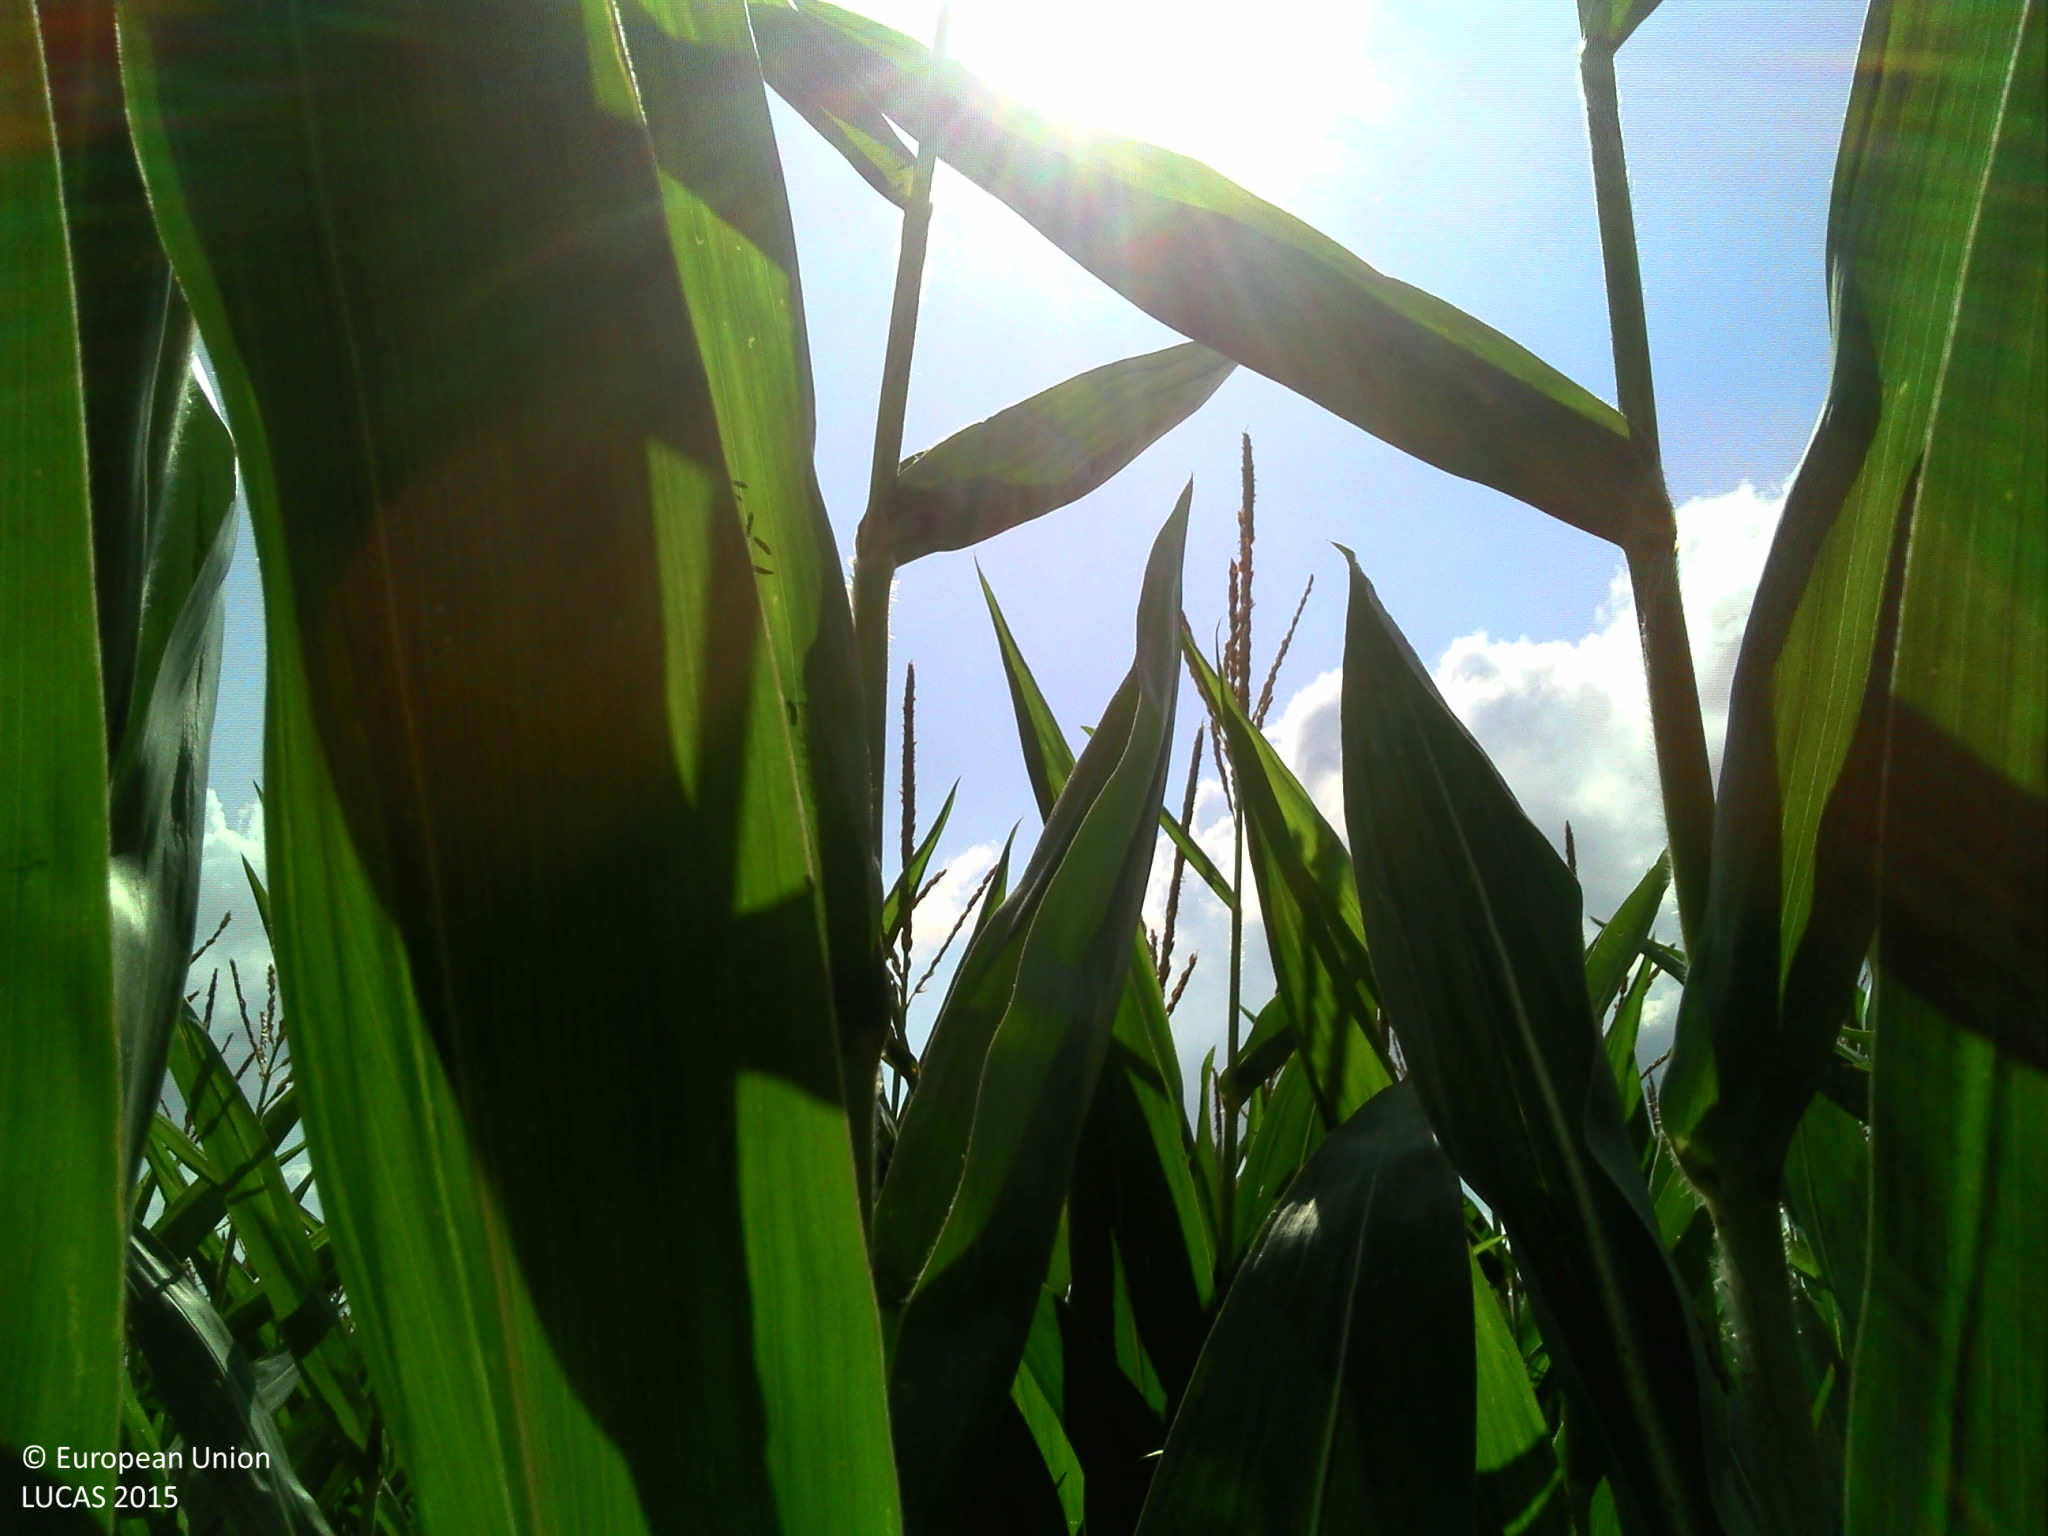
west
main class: Cropland
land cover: Maize
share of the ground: > 75 %
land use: Agriculture (excluding fallow land and kitchen gardens)
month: August
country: FR
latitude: 48.3156
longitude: -2.1242
